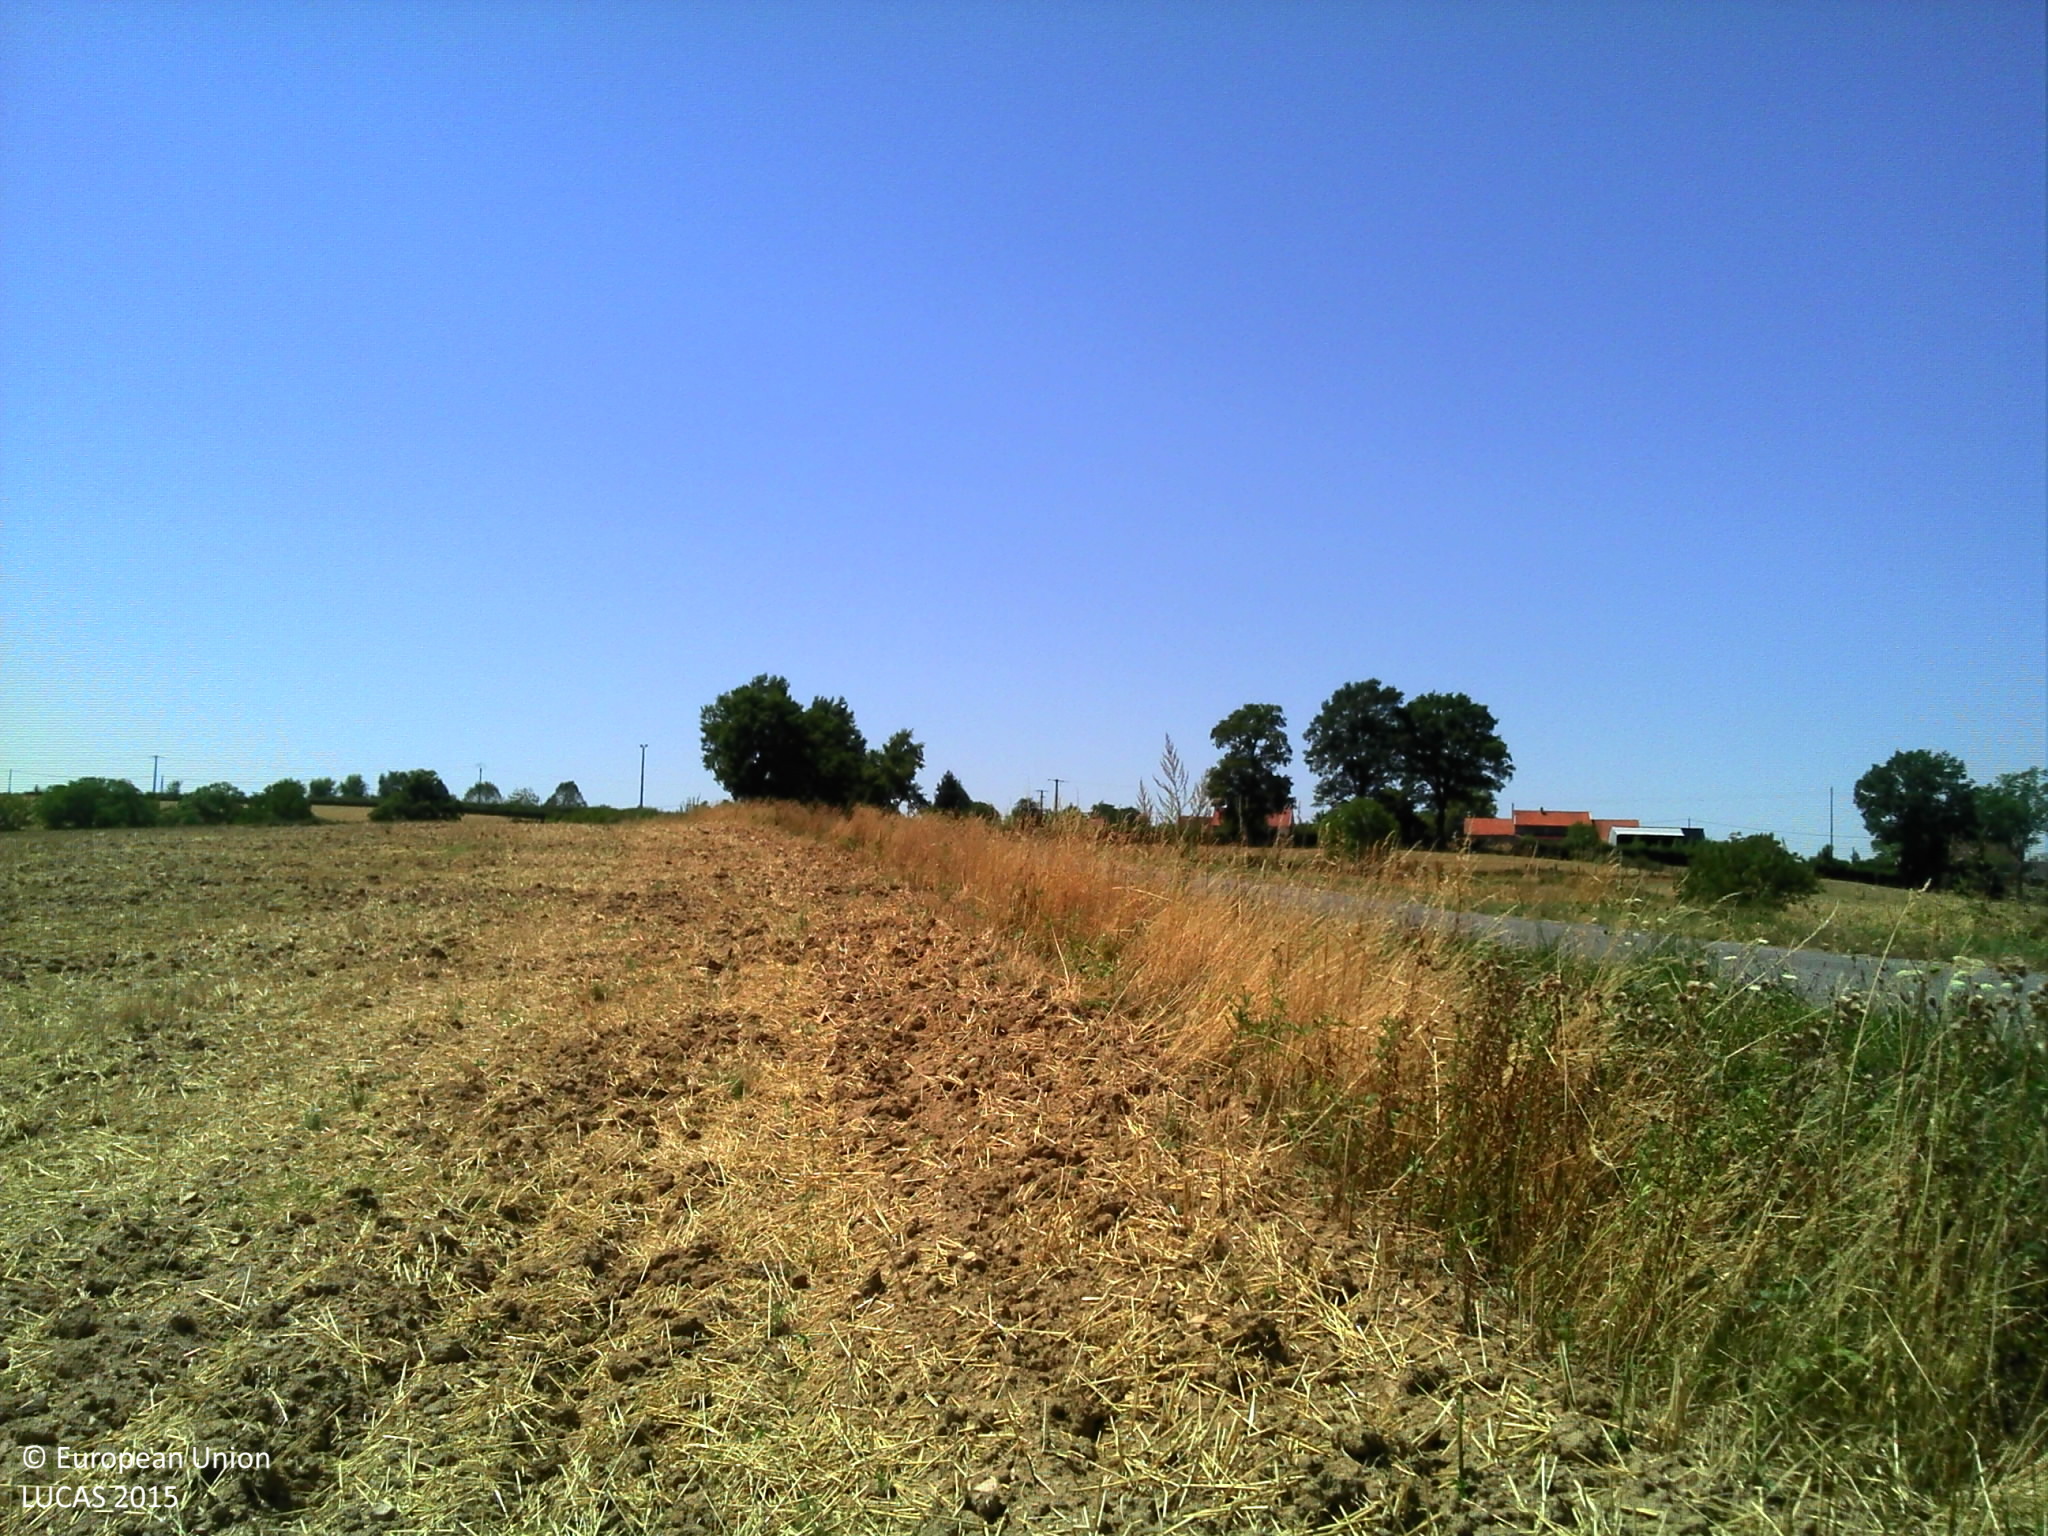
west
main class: Cropland
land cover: Triticale
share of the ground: 25 - 50 %
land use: Agriculture (excluding fallow land and kitchen gardens)
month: August
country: FR
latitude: 46.1082
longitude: 3.6480
